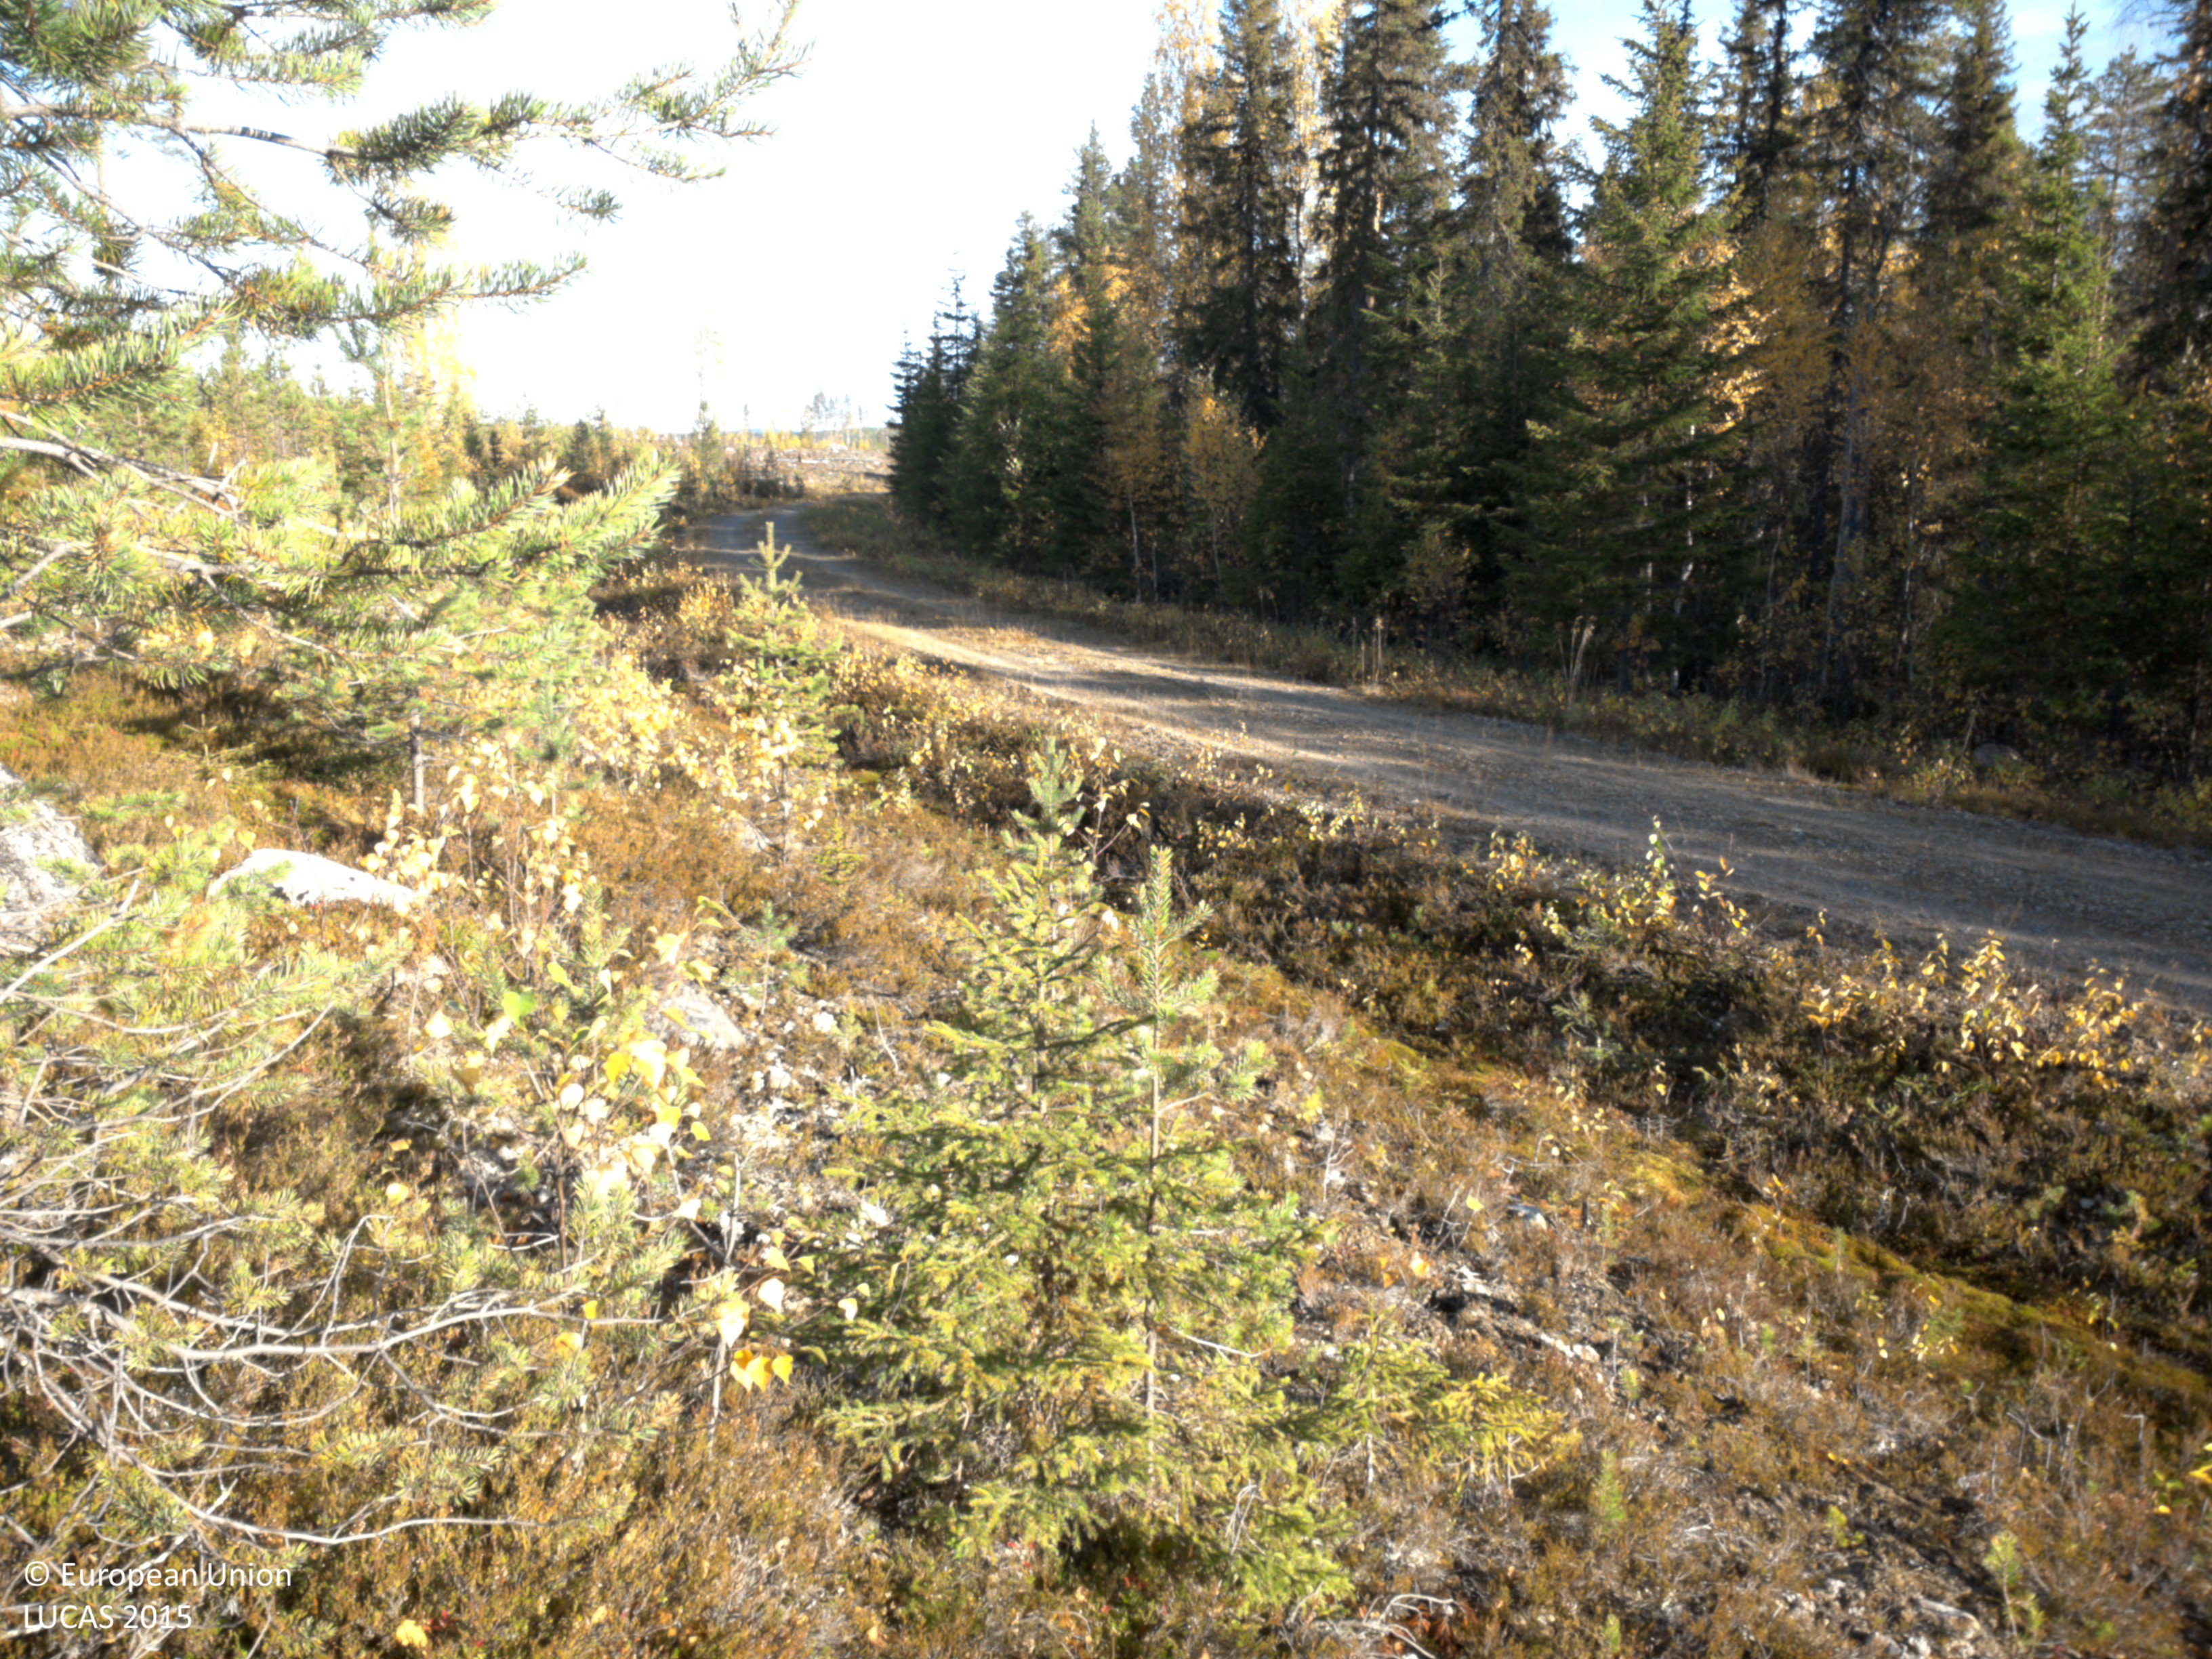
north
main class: Woodland
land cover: Pine dominated coniferous woodland
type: exotic forest
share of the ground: 50 - 75 %
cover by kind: coniferous forest trees 50 %, shrubs 30 %, broadleaved forest trees 10 %, herbaceous plants 5 %, lichens and mosses 5 %
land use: Forestry
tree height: < 5 m
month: September
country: SE
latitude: 64.8850
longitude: 18.3903
